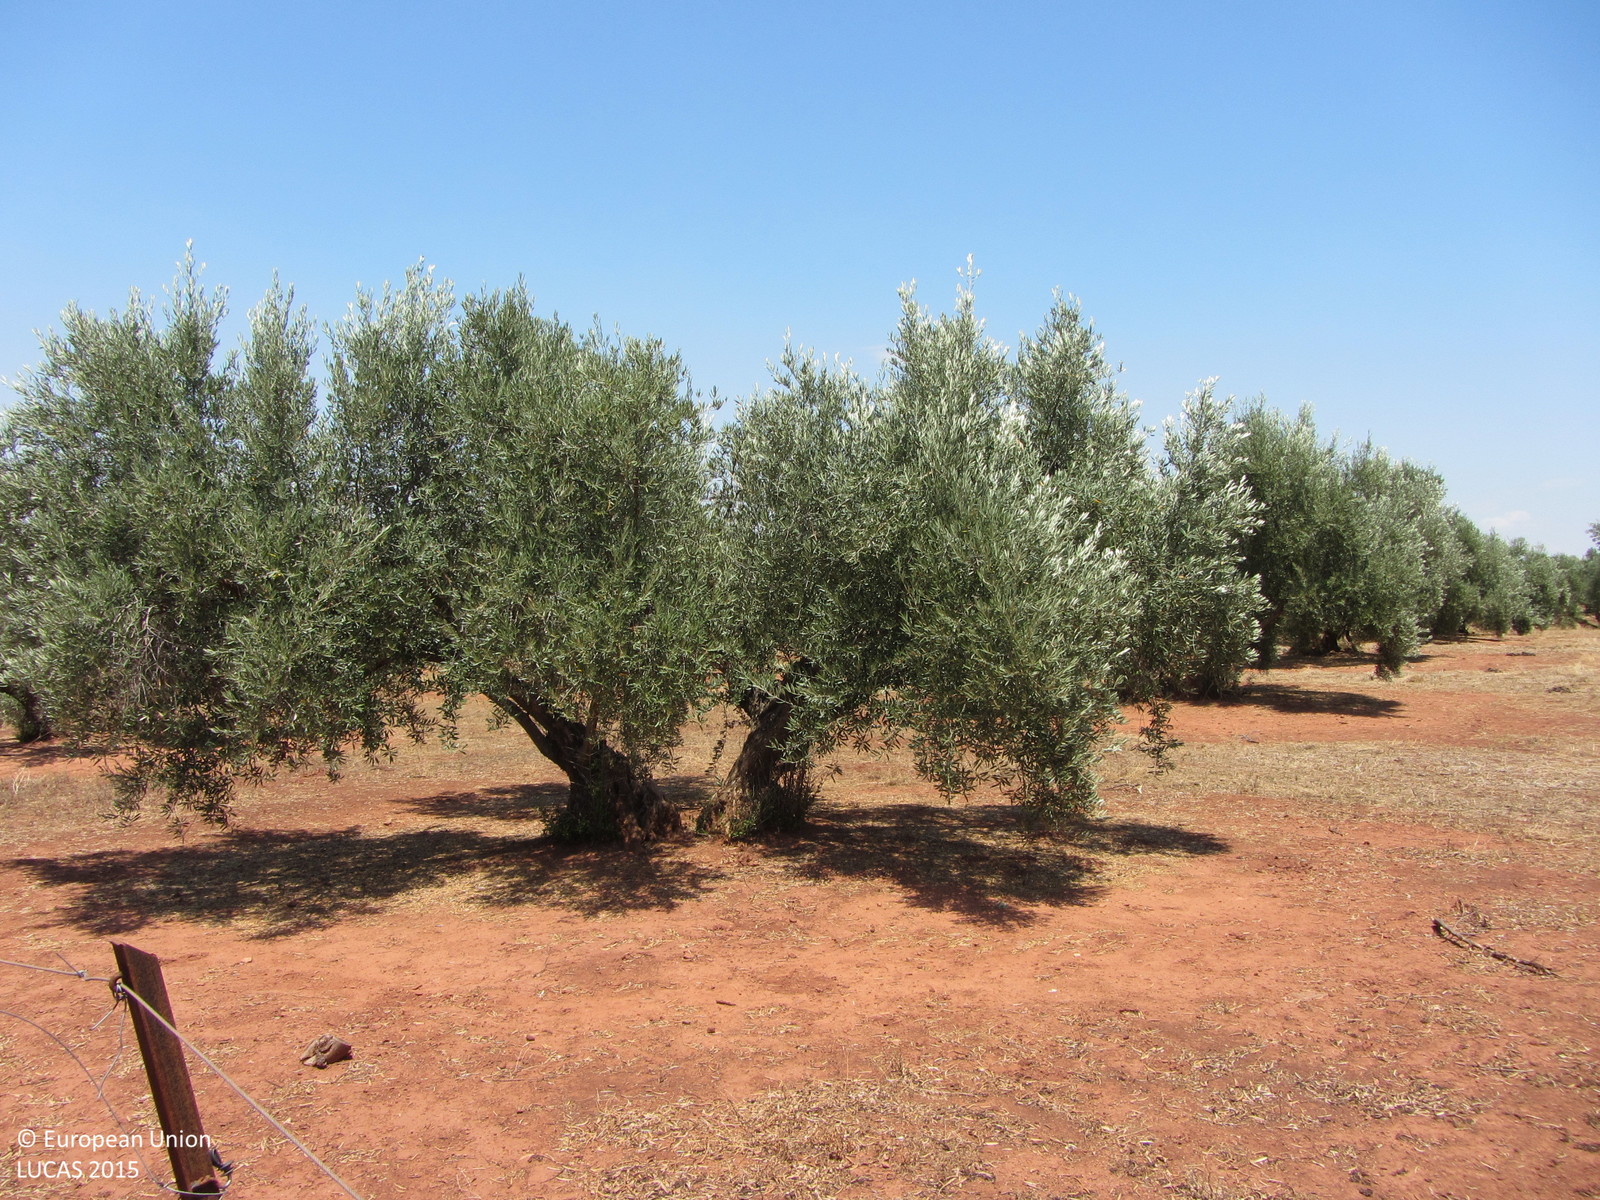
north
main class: Cropland
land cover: Olive groves
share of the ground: 25 - 50 %
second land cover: Other bare soil
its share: > 75 %
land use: Agriculture (excluding fallow land and kitchen gardens)
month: June
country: ES
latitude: 38.2011
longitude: -3.4440
